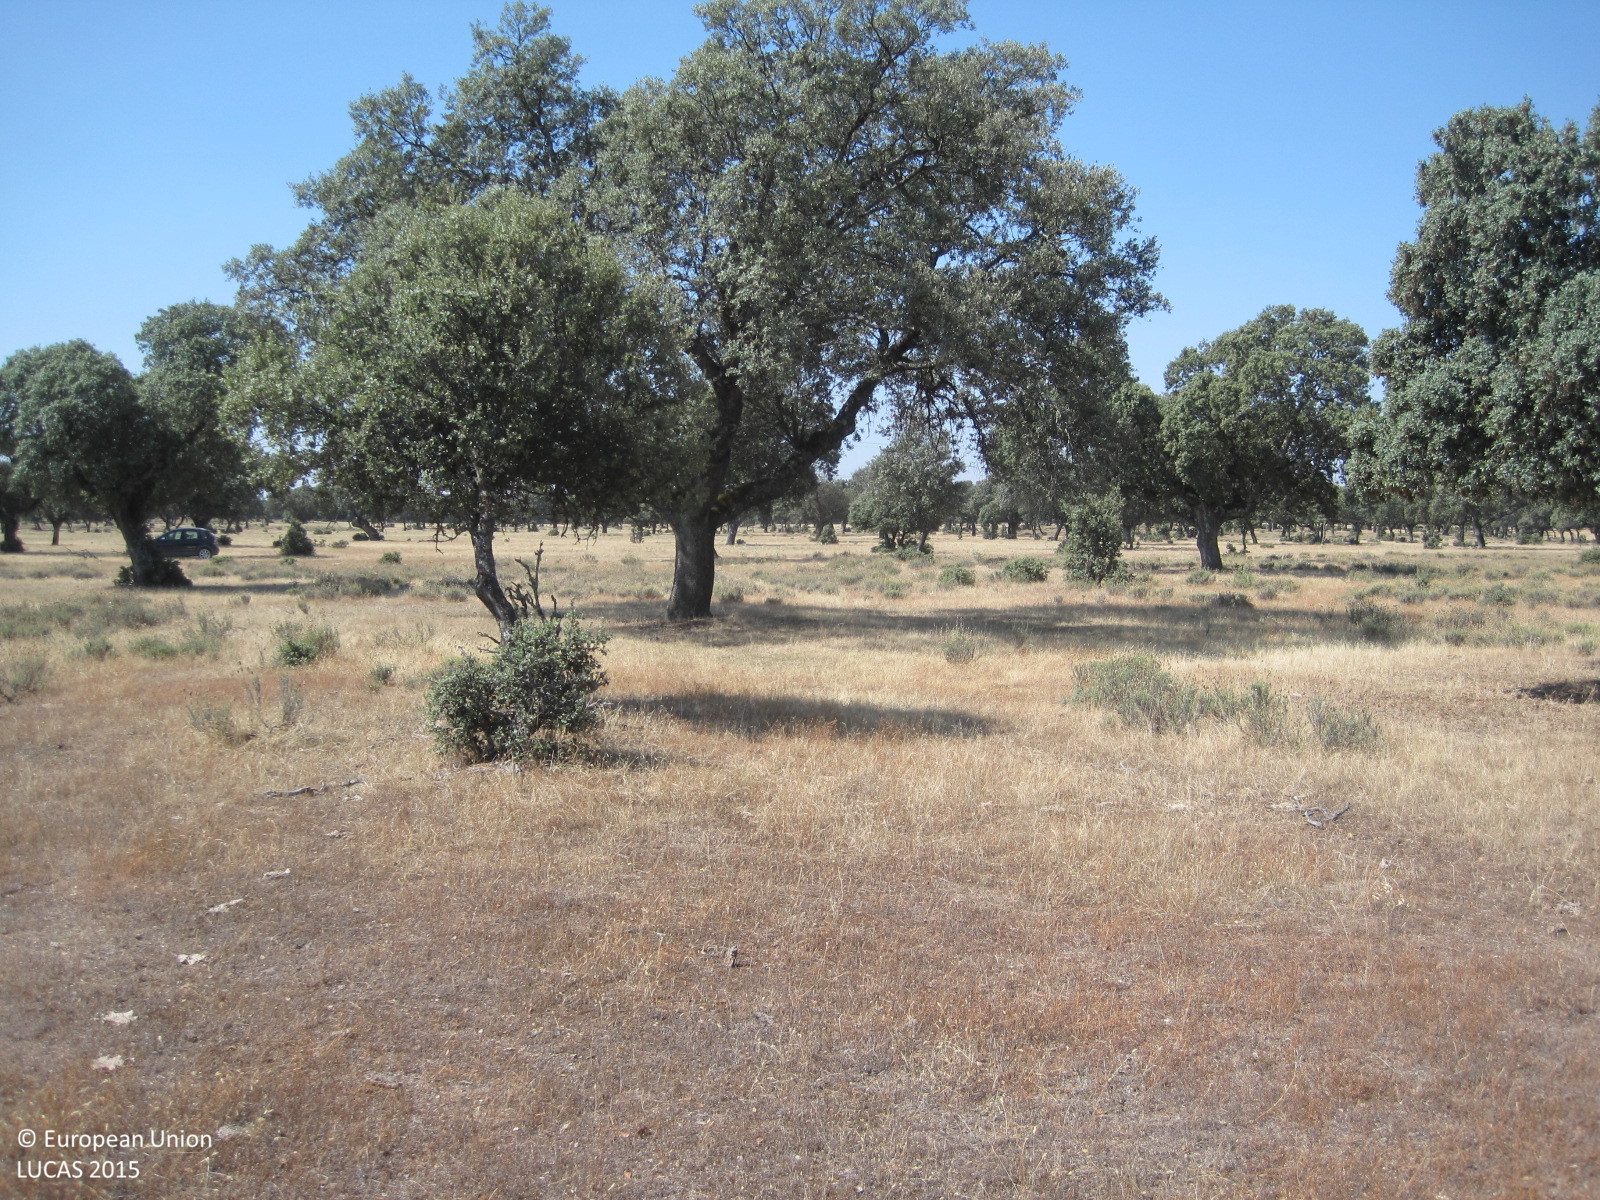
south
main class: Woodland
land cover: Broadleaved woodland
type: broadleaved evergreen forest
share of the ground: 25 - 50 %
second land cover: Grassland without tree/shrub cover
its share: > 75 %
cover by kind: herbaceous plants 65 %, broadleaved forest trees 35 %
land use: Forestry
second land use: Agriculture (excluding fallow land and kitchen gardens)
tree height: > 5 m
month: July
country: ES
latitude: 40.0121
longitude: -5.0835
